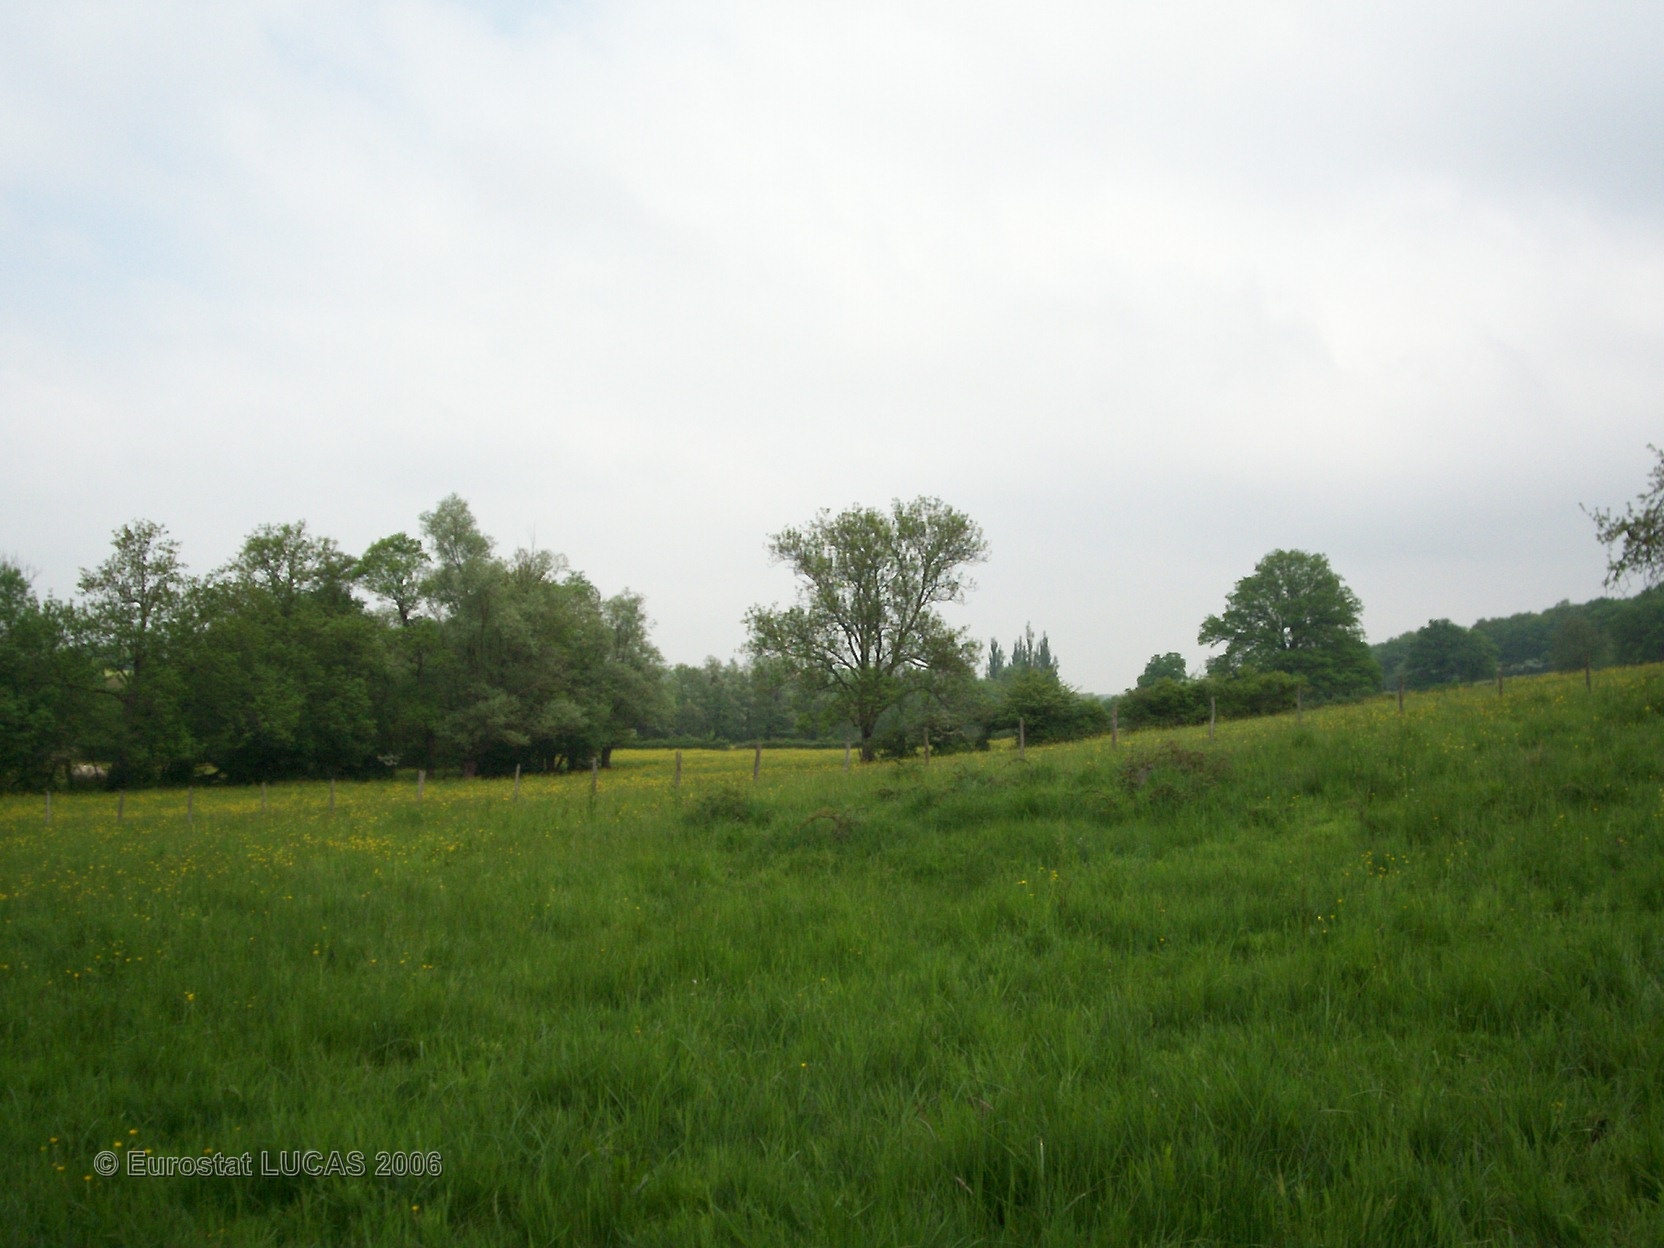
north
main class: Grassland
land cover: Grassland with sparse tree/shrub cover
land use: Agriculture (excluding fallow land and kitchen gardens)
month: May
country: FR
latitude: 46.5110
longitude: 4.7495
